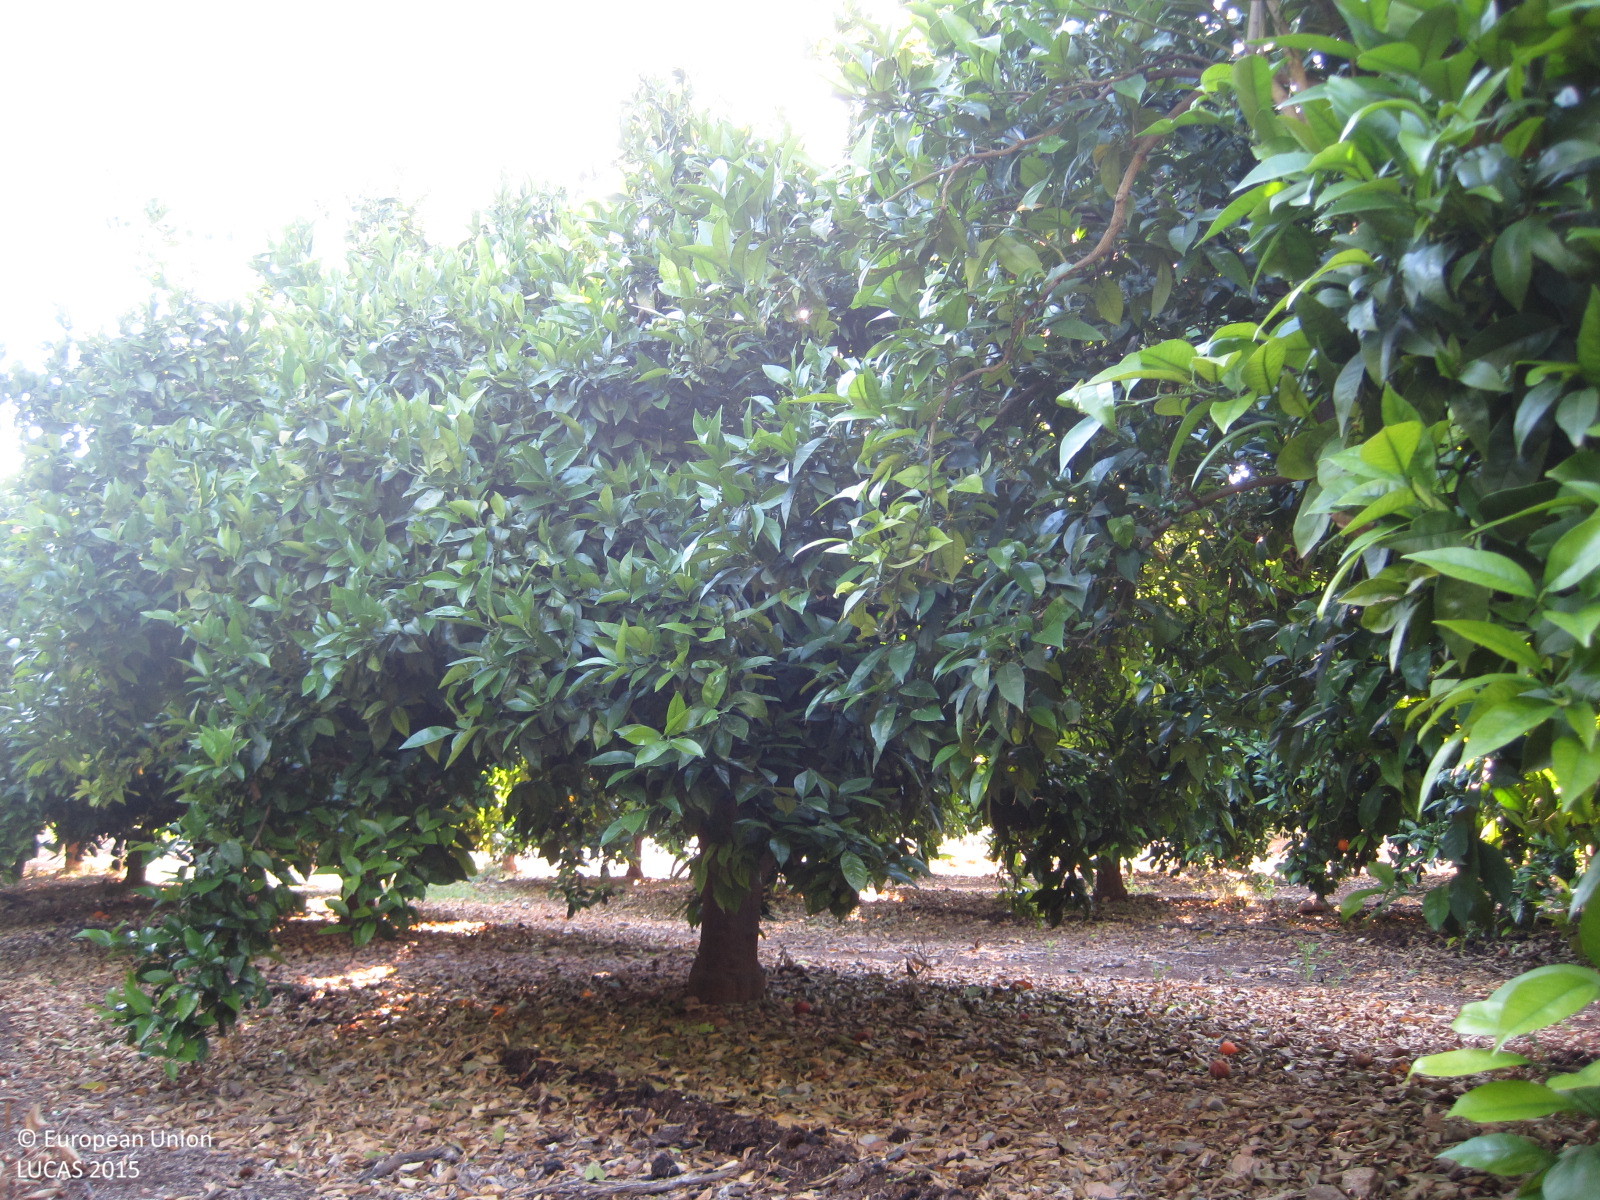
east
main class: Cropland
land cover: Oranges
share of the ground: > 75 %
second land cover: Other bare soil
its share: > 75 %
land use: Agriculture (excluding fallow land and kitchen gardens)
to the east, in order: Oranges; Other bare soil; Dry stone walls; Oranges; Ditches and canals; Grass margins; Tracks; Grass margins; Oranges; Grass margins; Dry stone walls; Ditches and canals; Oranges; Grass margins; Ditches and canals; Spontaneously vegetated surfaces; Nuts trees
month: May
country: ES
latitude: 39.7171
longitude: -0.6986
